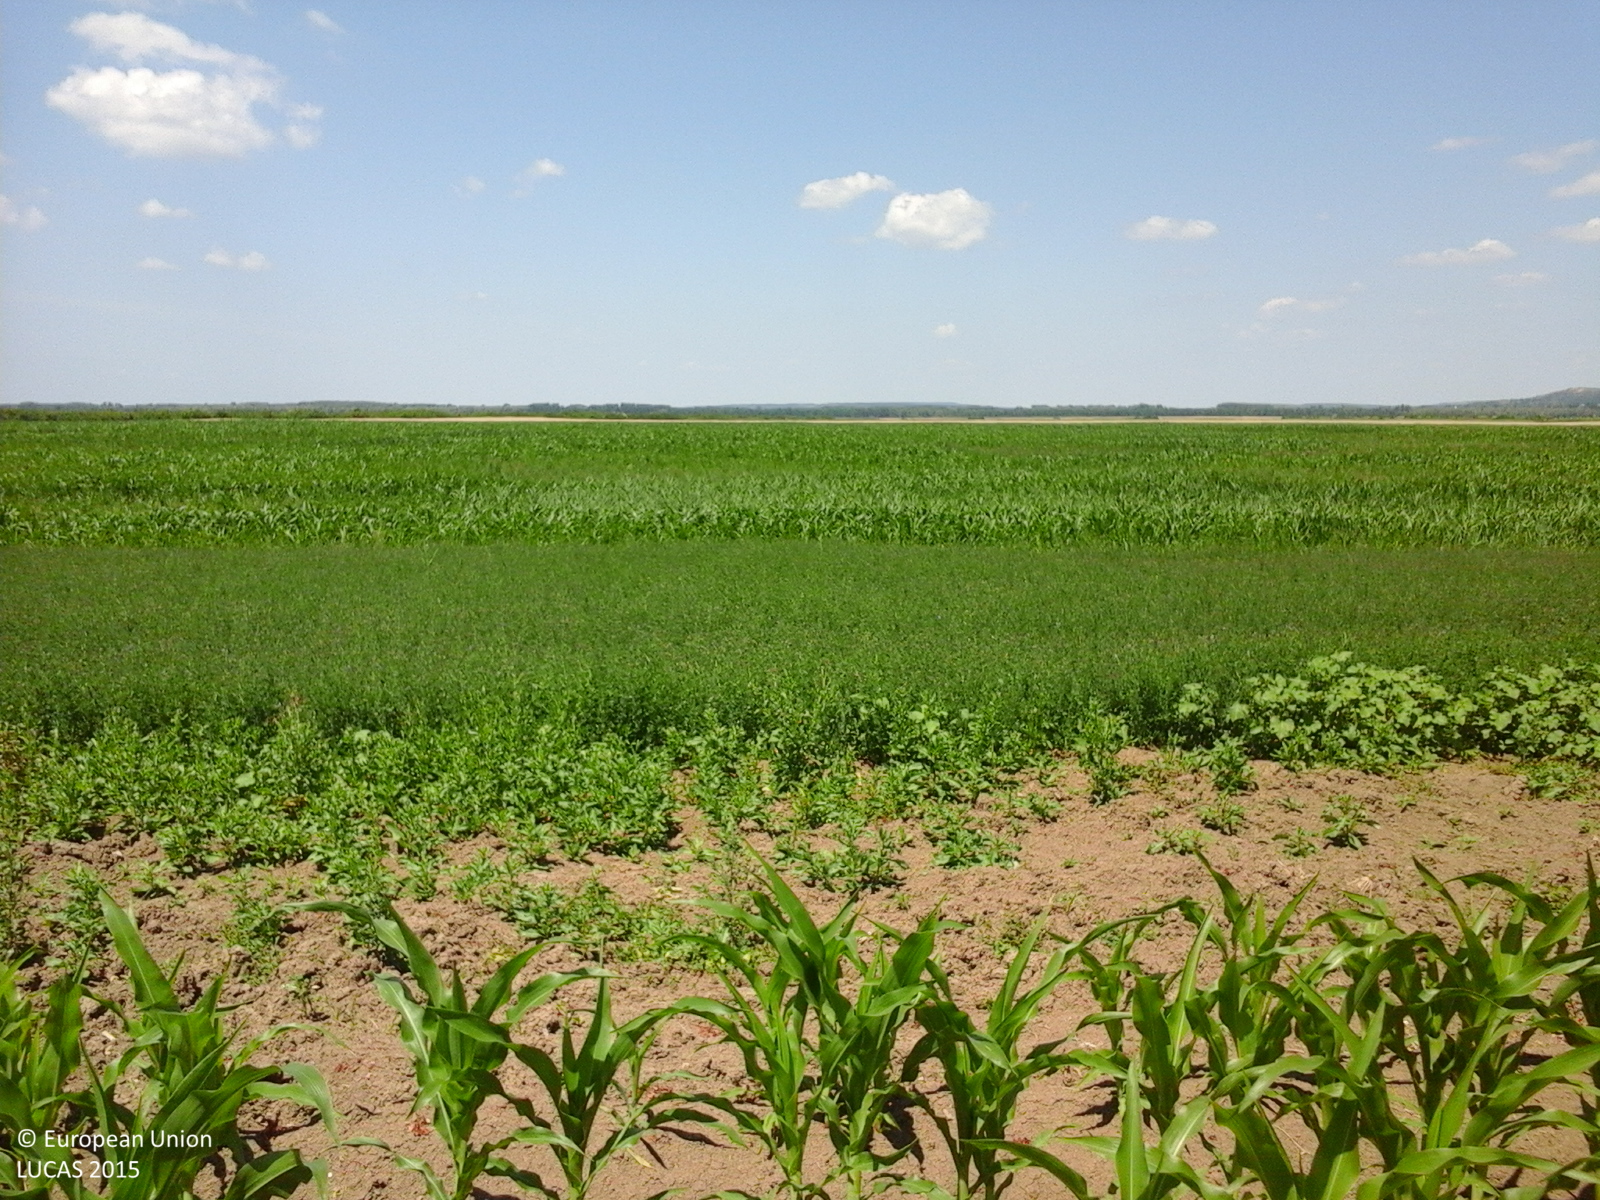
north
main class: Cropland
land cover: Maize
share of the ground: 50 - 75 %
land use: Agriculture (excluding fallow land and kitchen gardens)
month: June
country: RO
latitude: 47.4481
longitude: 27.5321
